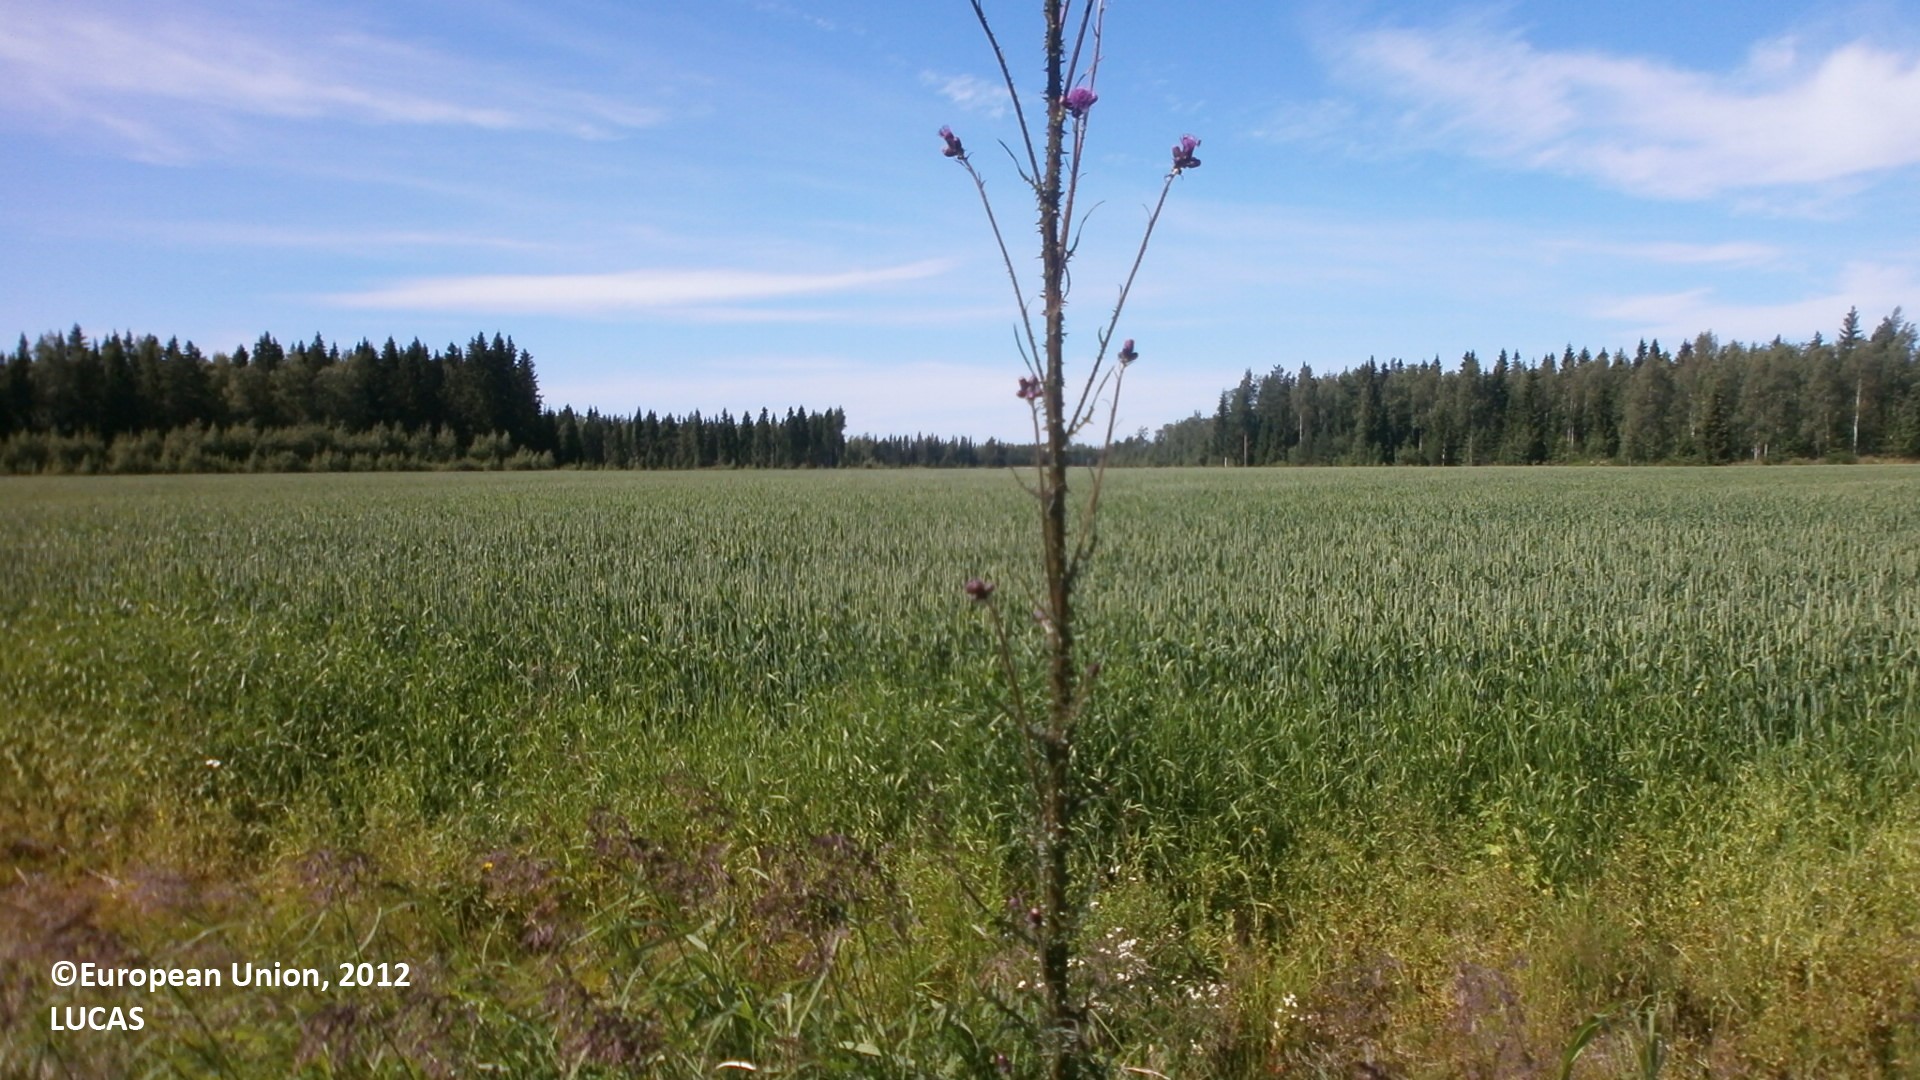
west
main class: Cropland
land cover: Temporary grasslands
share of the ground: > 75 %
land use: Agriculture (excluding fallow land and kitchen gardens)
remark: Harvested field
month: July
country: FI
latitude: 64.3763
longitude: 24.0516
